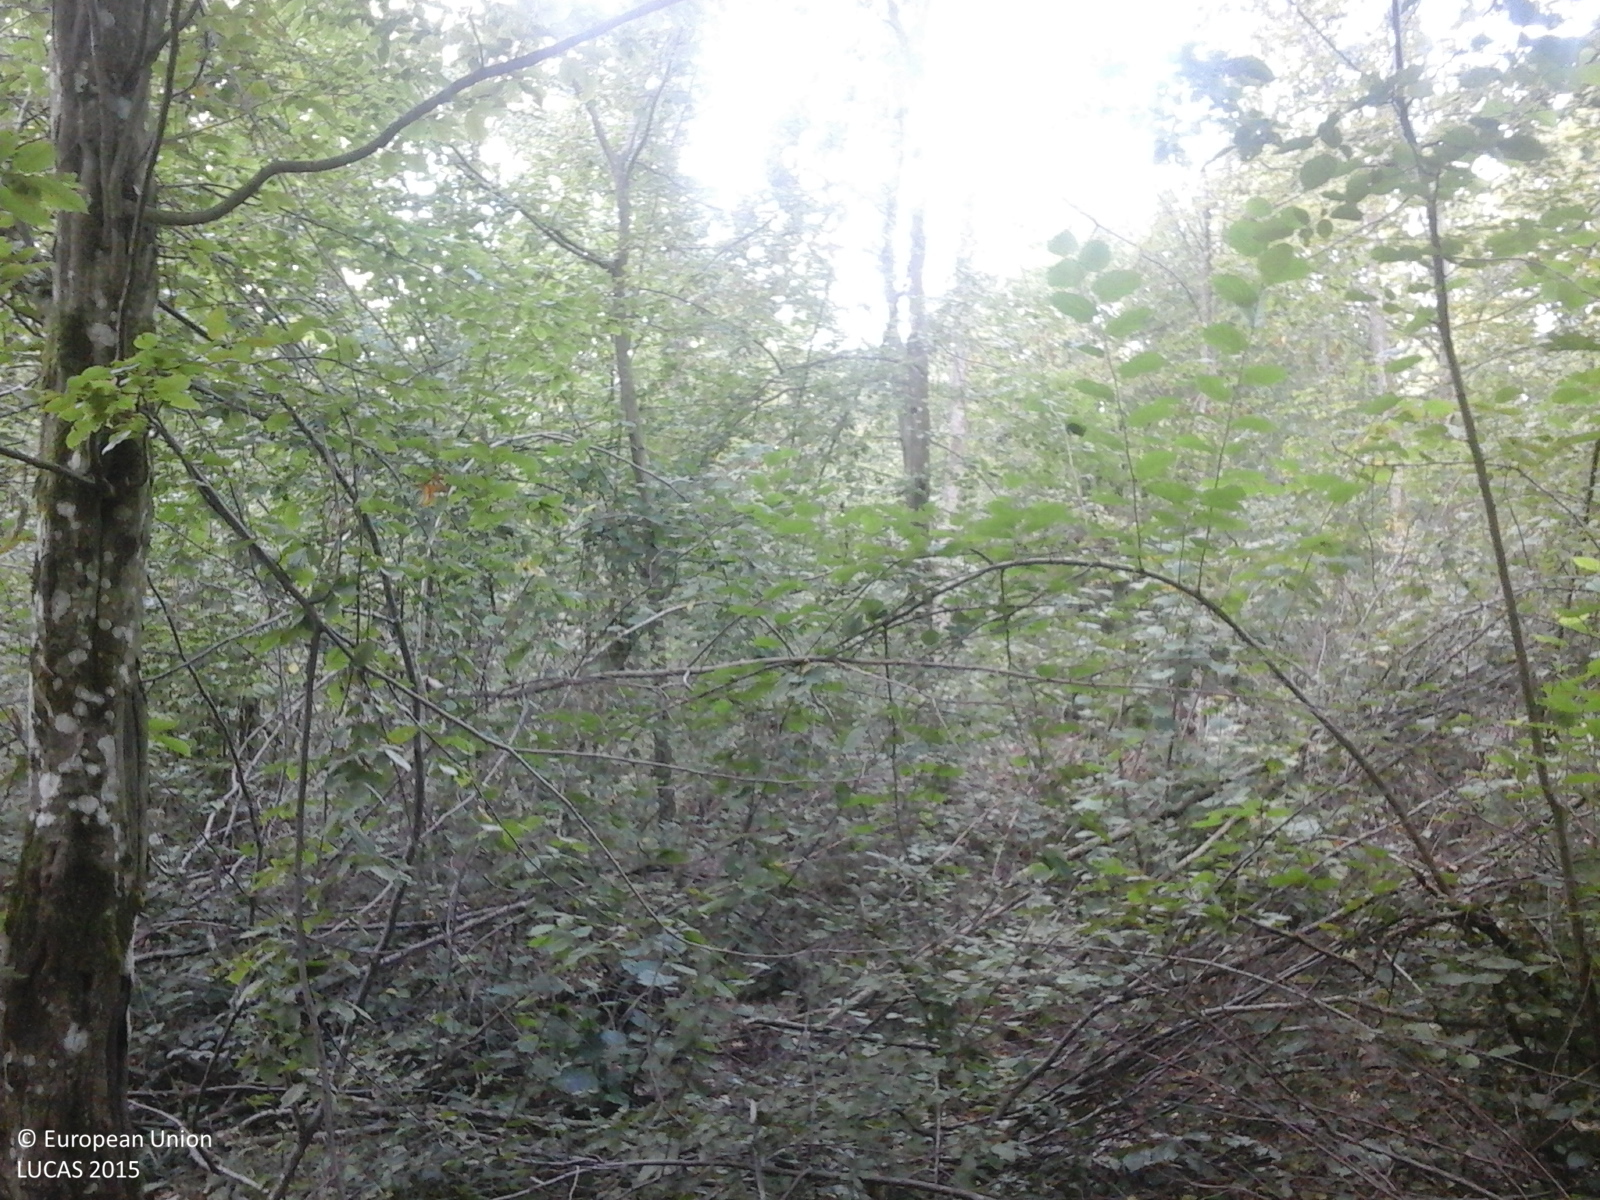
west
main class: Woodland
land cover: Broadleaved woodland
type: beech forest
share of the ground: > 75 %
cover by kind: broadleaved forest trees 90 %, herbaceous plants 10 %
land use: Forestry
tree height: > 5 m
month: September
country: RO
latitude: 47.5083
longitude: 23.4160
